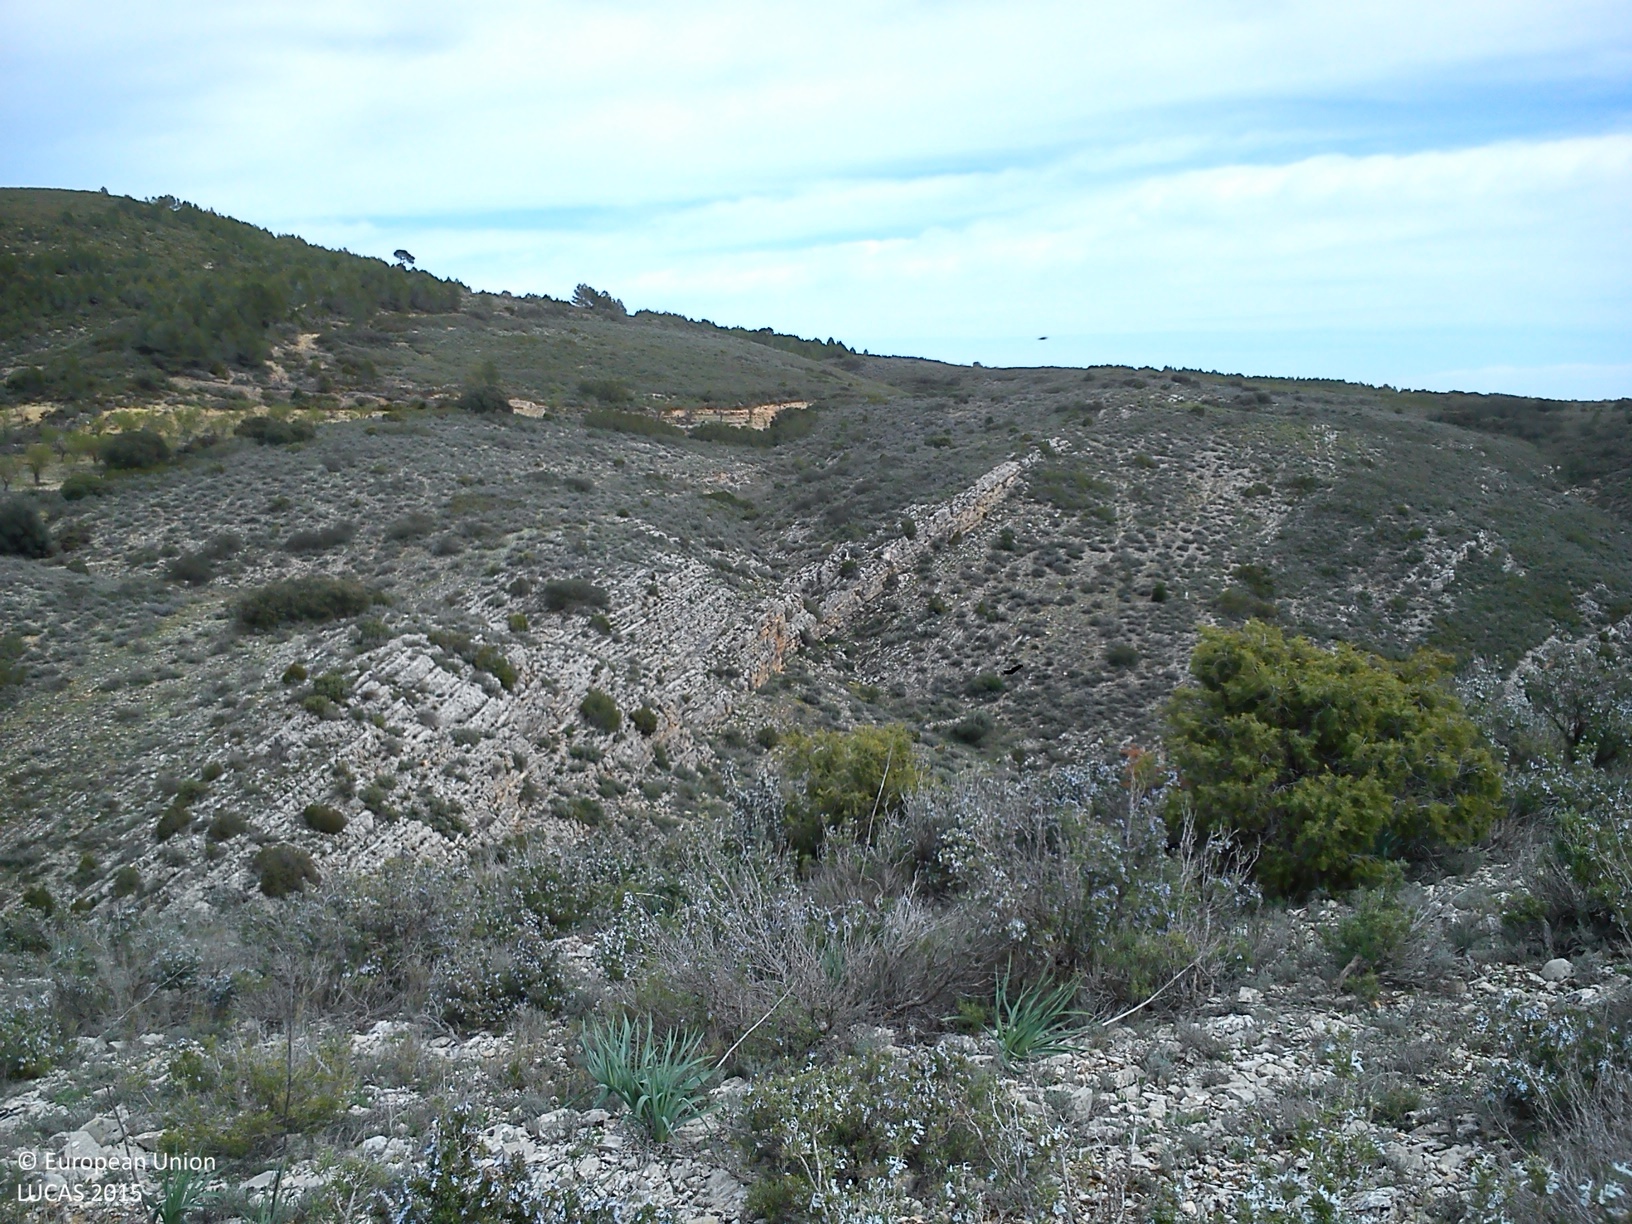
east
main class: Shrubland
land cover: Shrubland without tree cover
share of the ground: > 75 %
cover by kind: shrubs 40 %, consolidated bare surface 40 %, herbaceous plants 20 %
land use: Semi-natural and natural areas not in use
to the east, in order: Shrubland without tree cover; Grassland without tree/shrub cover; Shrubland without tree cover
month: March
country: ES
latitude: 39.4944
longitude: -0.8956
